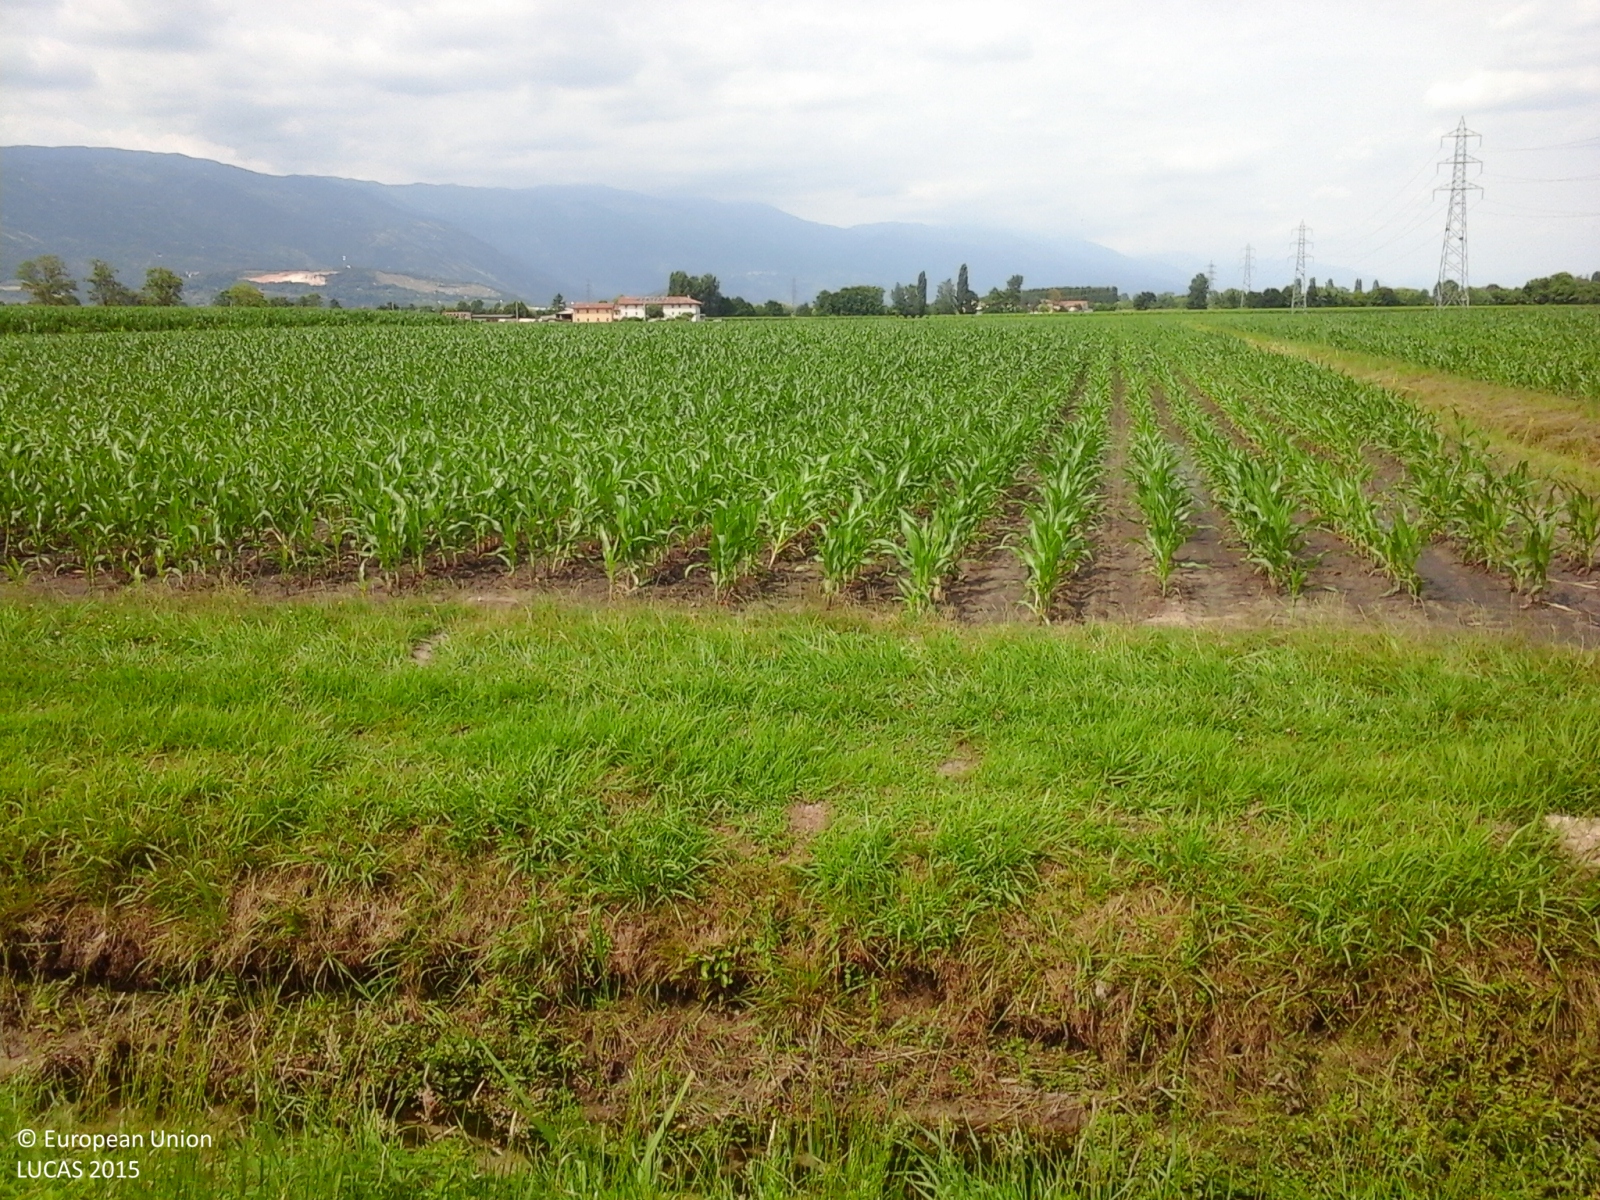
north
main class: Cropland
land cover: Maize
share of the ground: > 75 %
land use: Agriculture (excluding fallow land and kitchen gardens)
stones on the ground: < 10 %
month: June
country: IT
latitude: 45.9265
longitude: 12.4598
